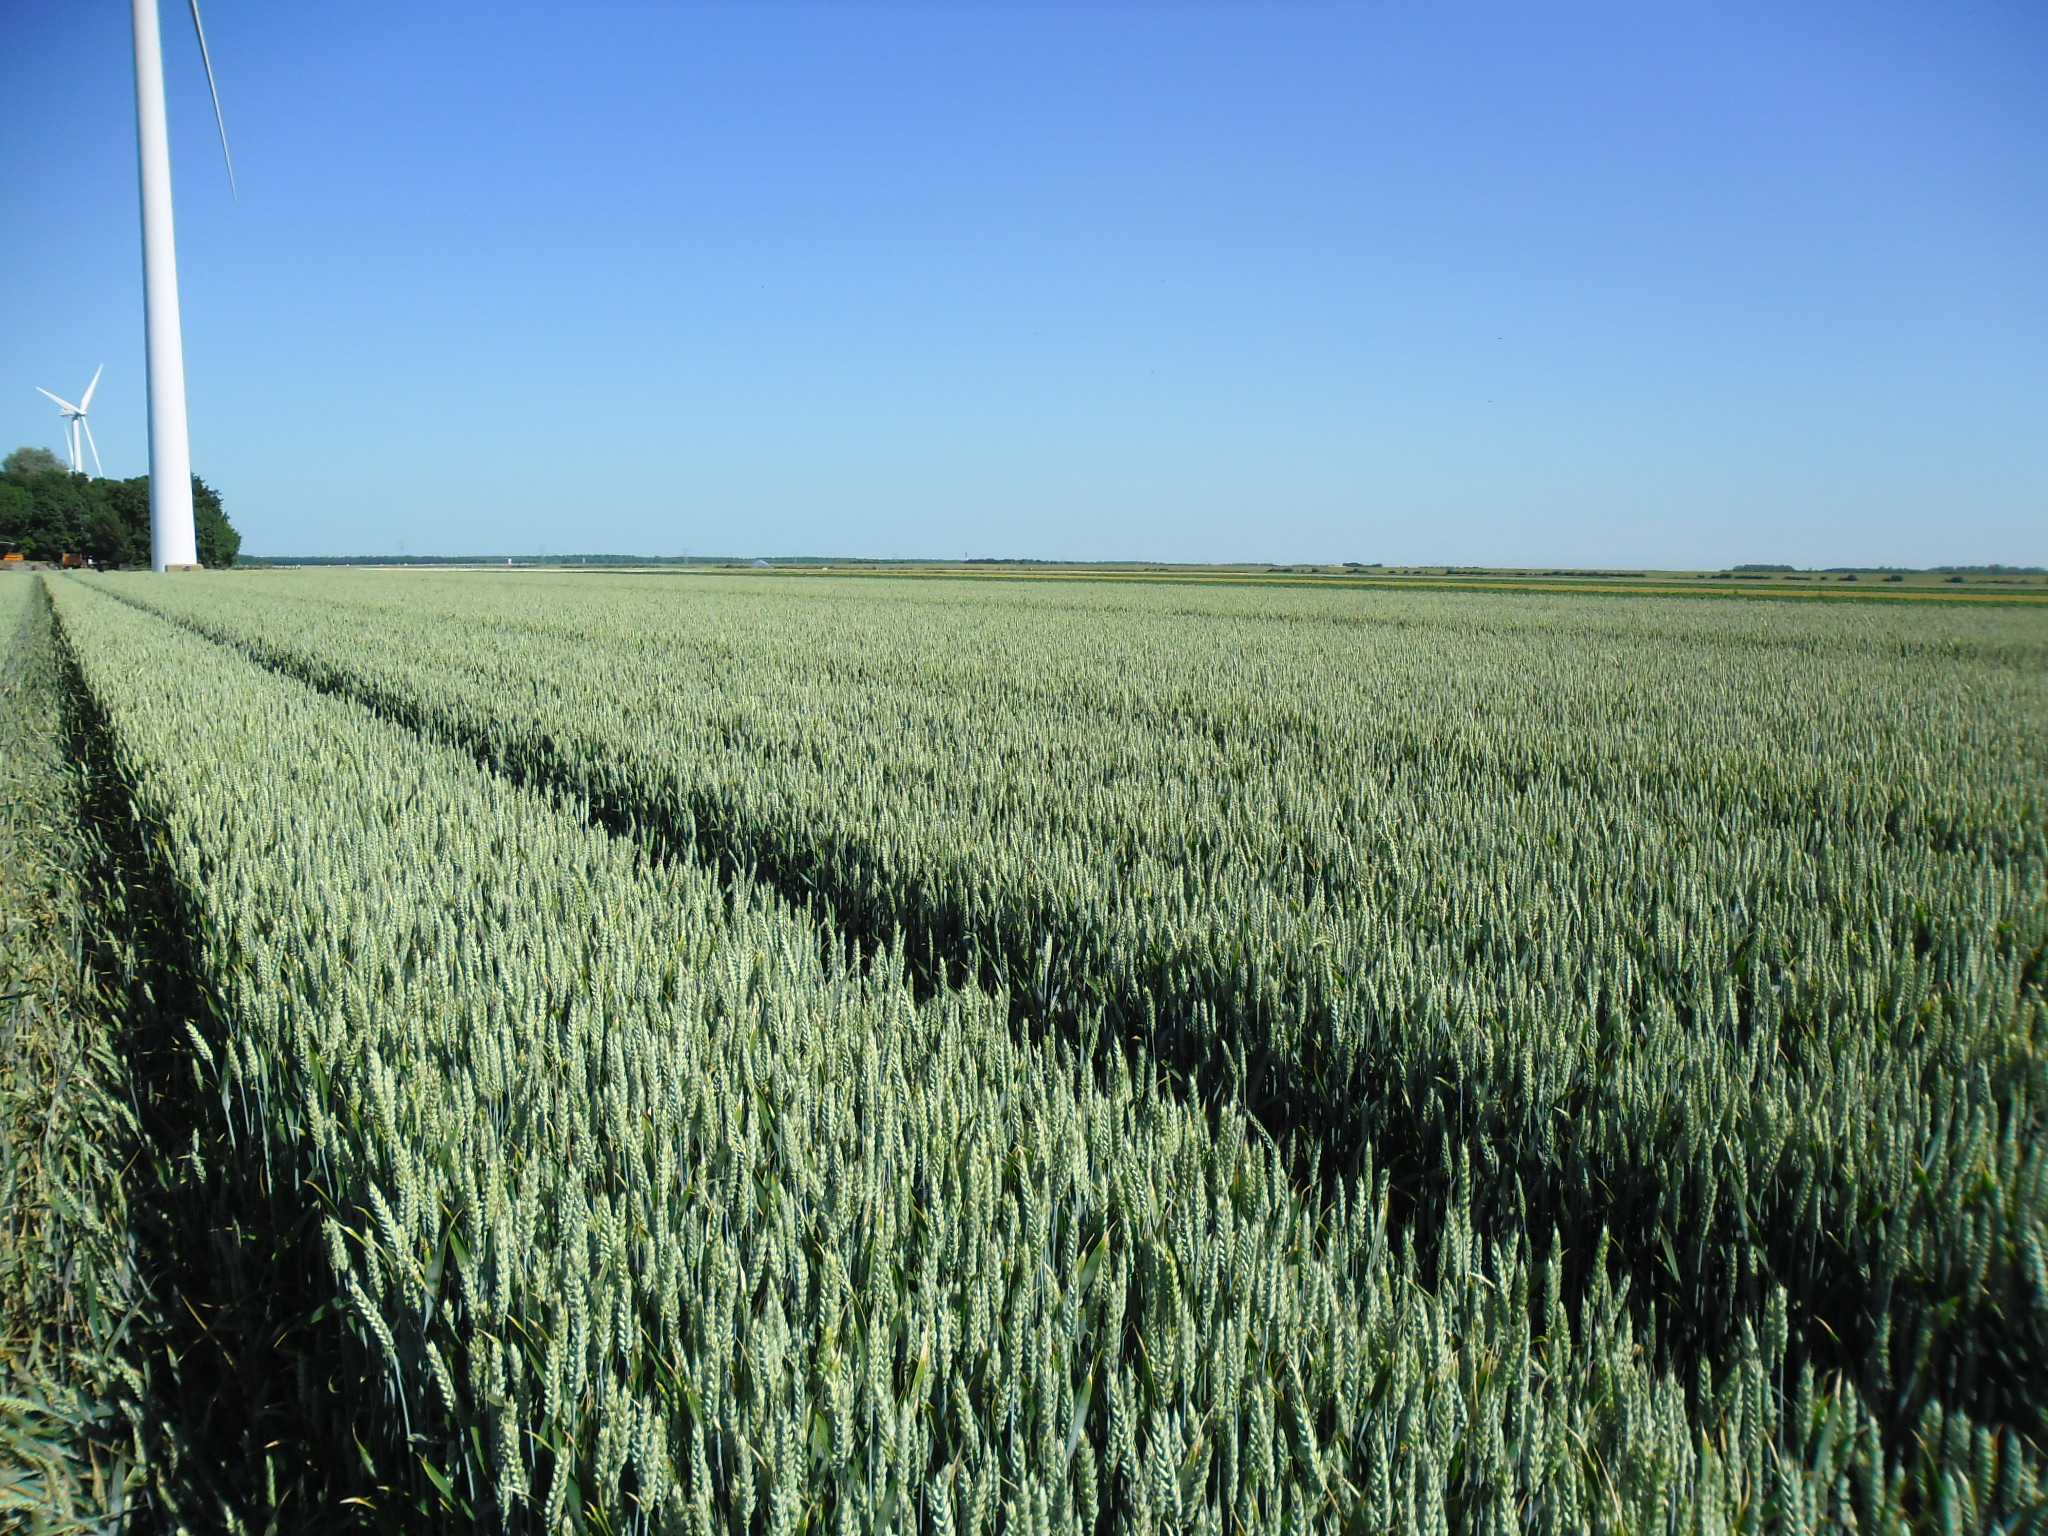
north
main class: Cropland
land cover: Common wheat
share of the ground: > 75 %
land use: Agriculture (excluding fallow land and kitchen gardens)
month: June
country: NL
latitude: 52.4165
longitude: 5.4551
